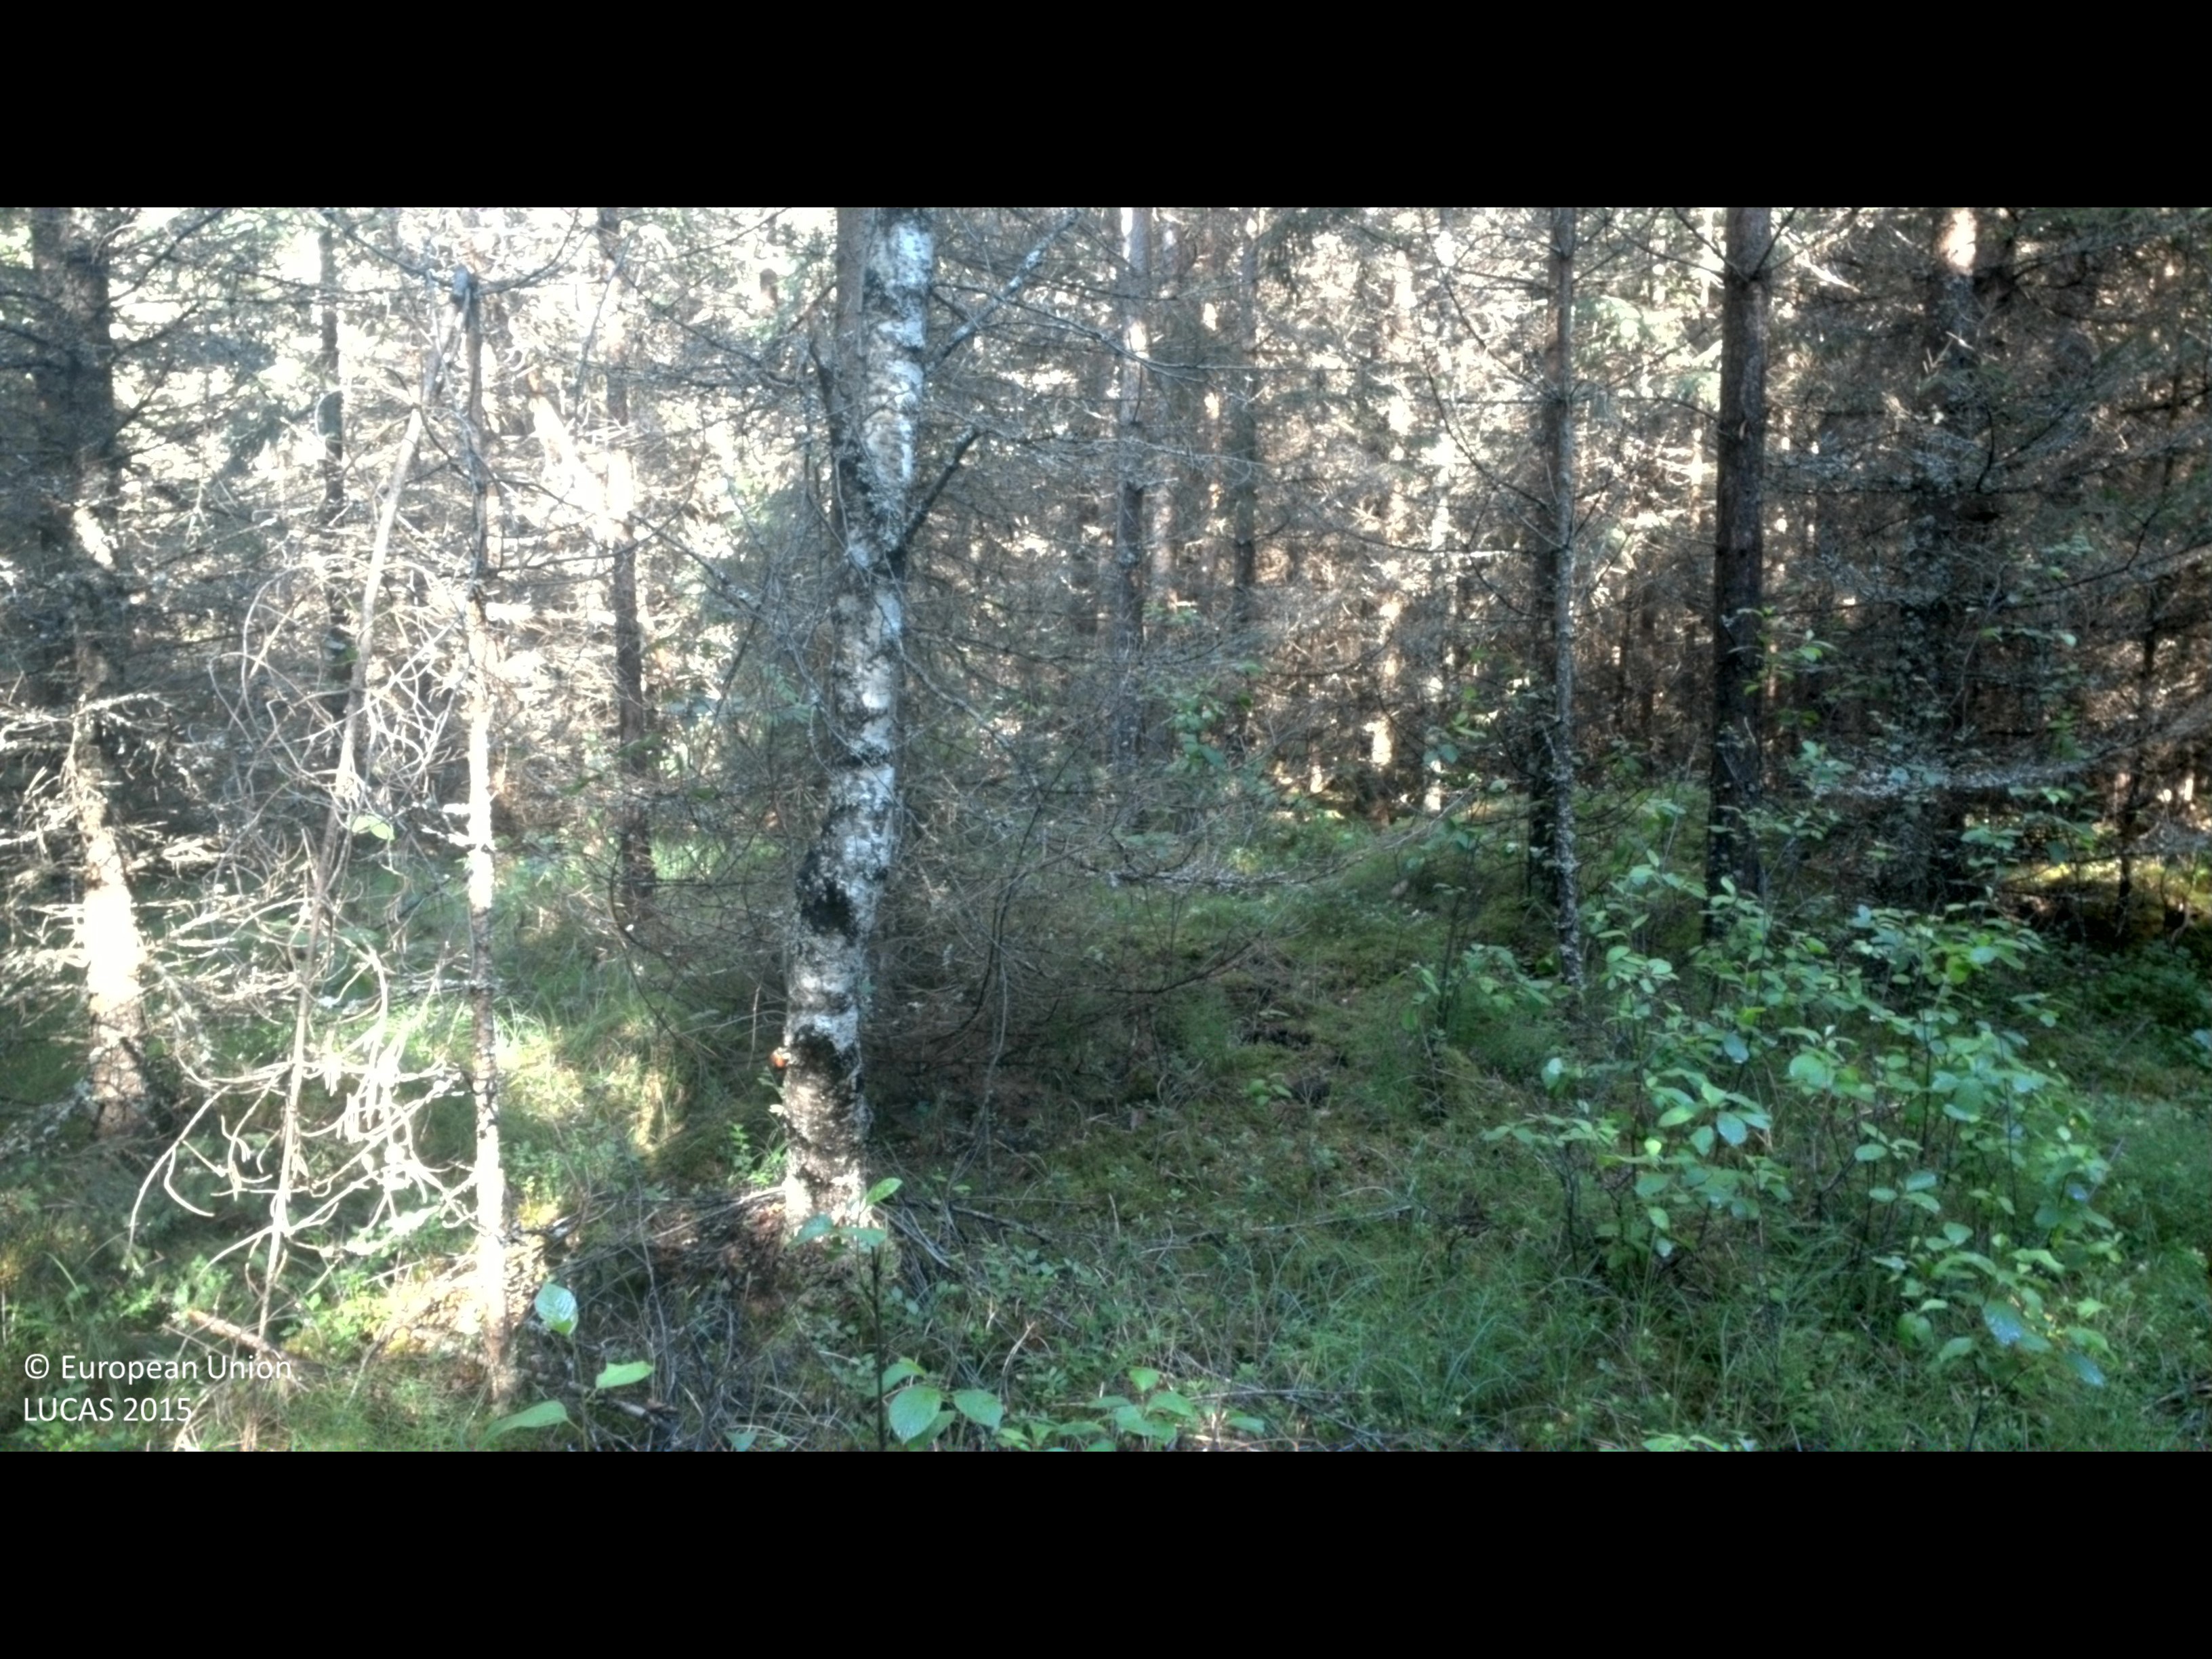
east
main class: Woodland
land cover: Spruce dominated coniferous woodland
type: boreal forest
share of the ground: > 75 %
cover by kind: coniferous forest trees 80 %, broadleaved forest trees 10 %, shrubs 5 %, herbaceous plants 5 %
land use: Forestry
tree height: > 5 m
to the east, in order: Spruce dominated coniferous woodland; Pine dominated coniferous woodland; Spruce dominated mixed woodland; Broadleaved woodland; Other mixed woodland; Pine dominated coniferous woodland
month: July
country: SE
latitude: 58.4010
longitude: 16.2070
